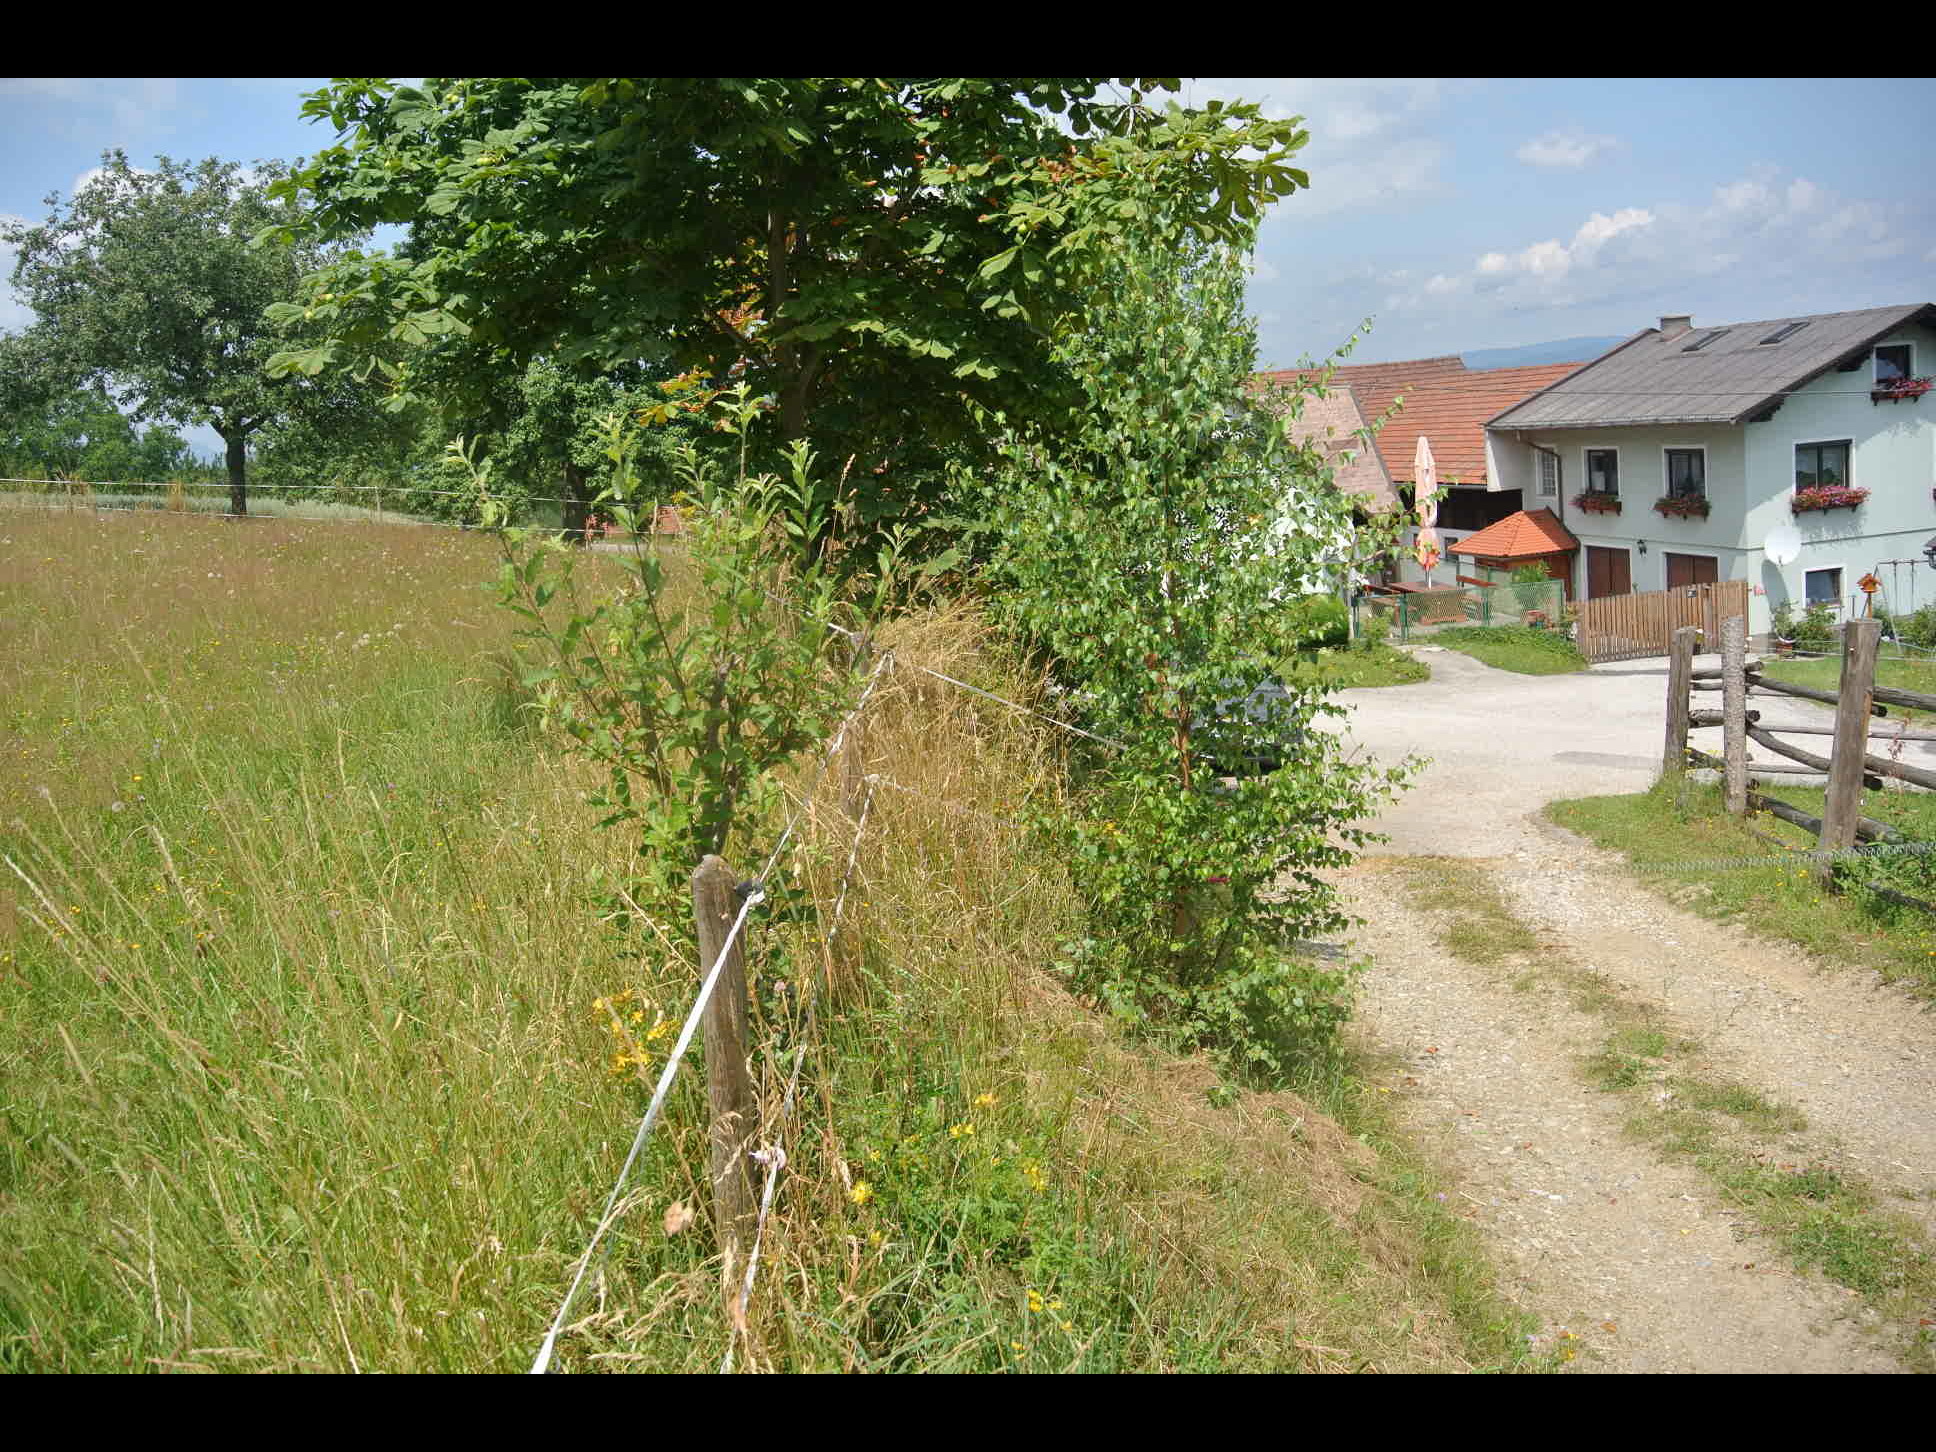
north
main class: Cropland
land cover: Temporary grasslands
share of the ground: > 75 %
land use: Agriculture (excluding fallow land and kitchen gardens)
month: July
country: AT
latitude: 47.6447
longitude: 16.0062
